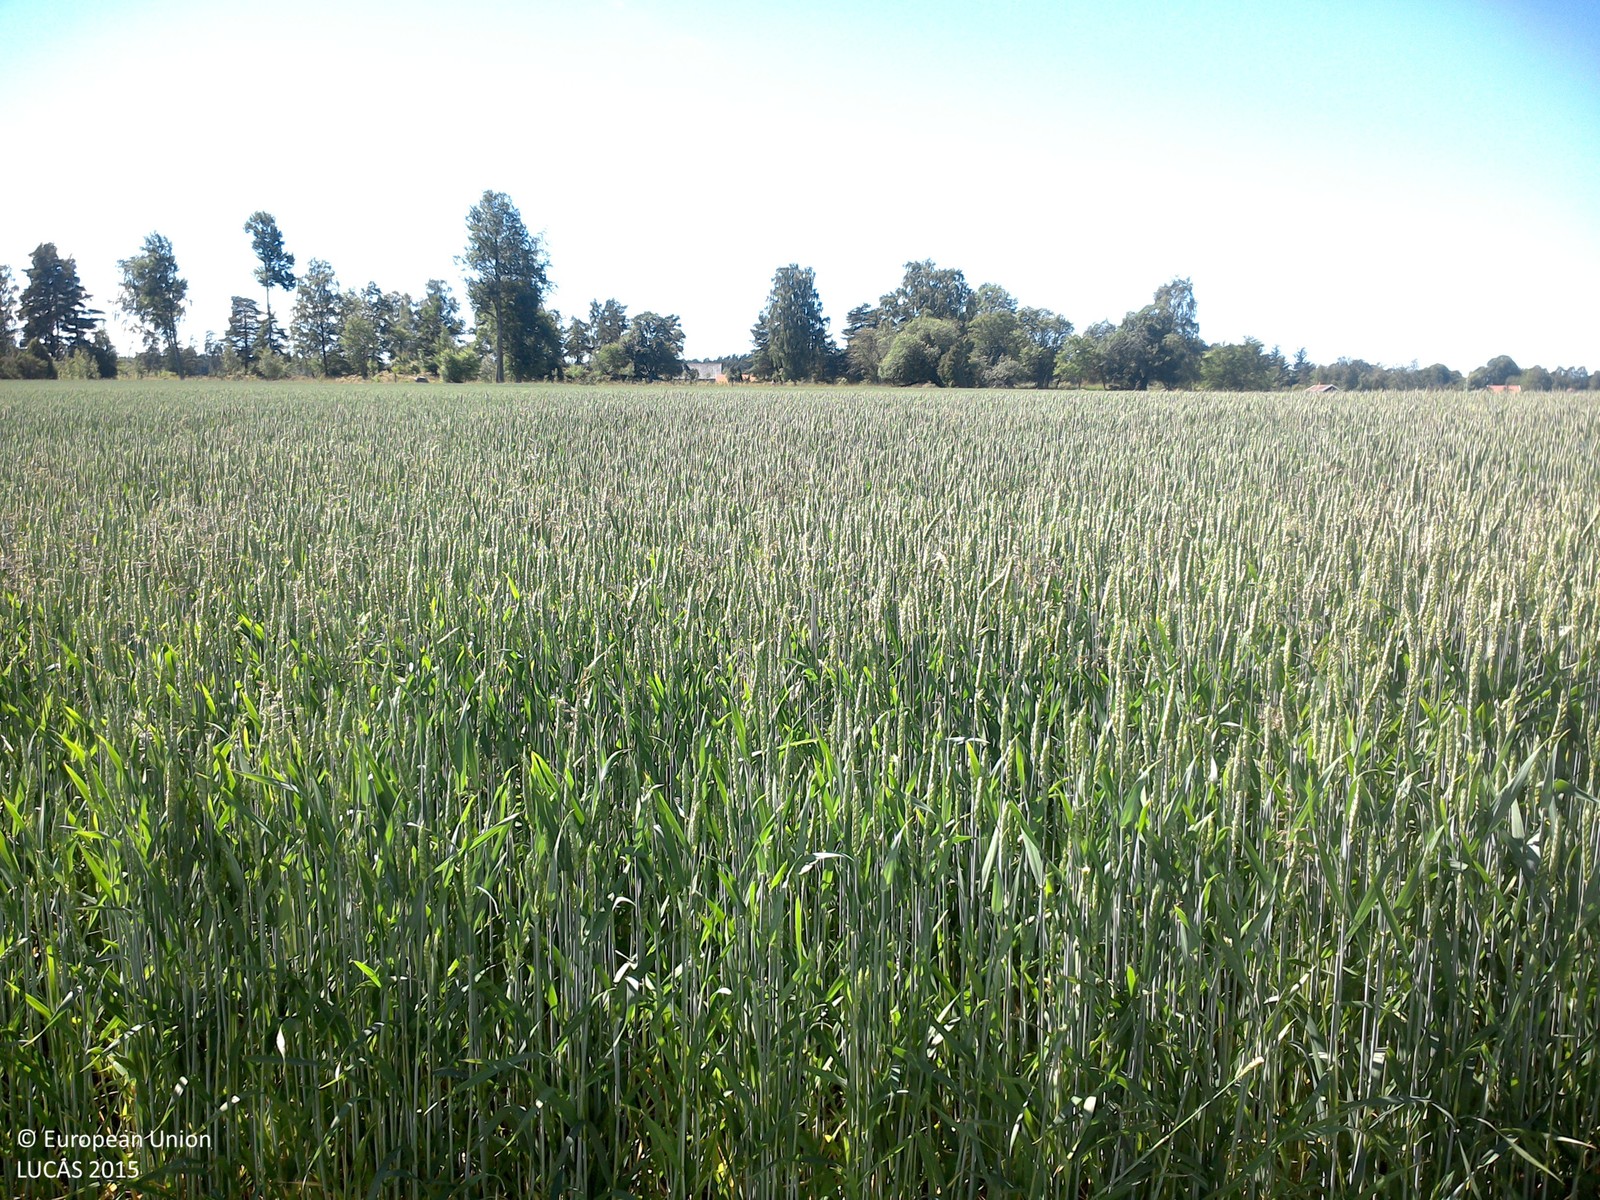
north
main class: Cropland
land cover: Common wheat
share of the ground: > 75 %
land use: Agriculture (excluding fallow land and kitchen gardens)
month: July
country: SE
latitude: 58.3616
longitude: 15.4468
